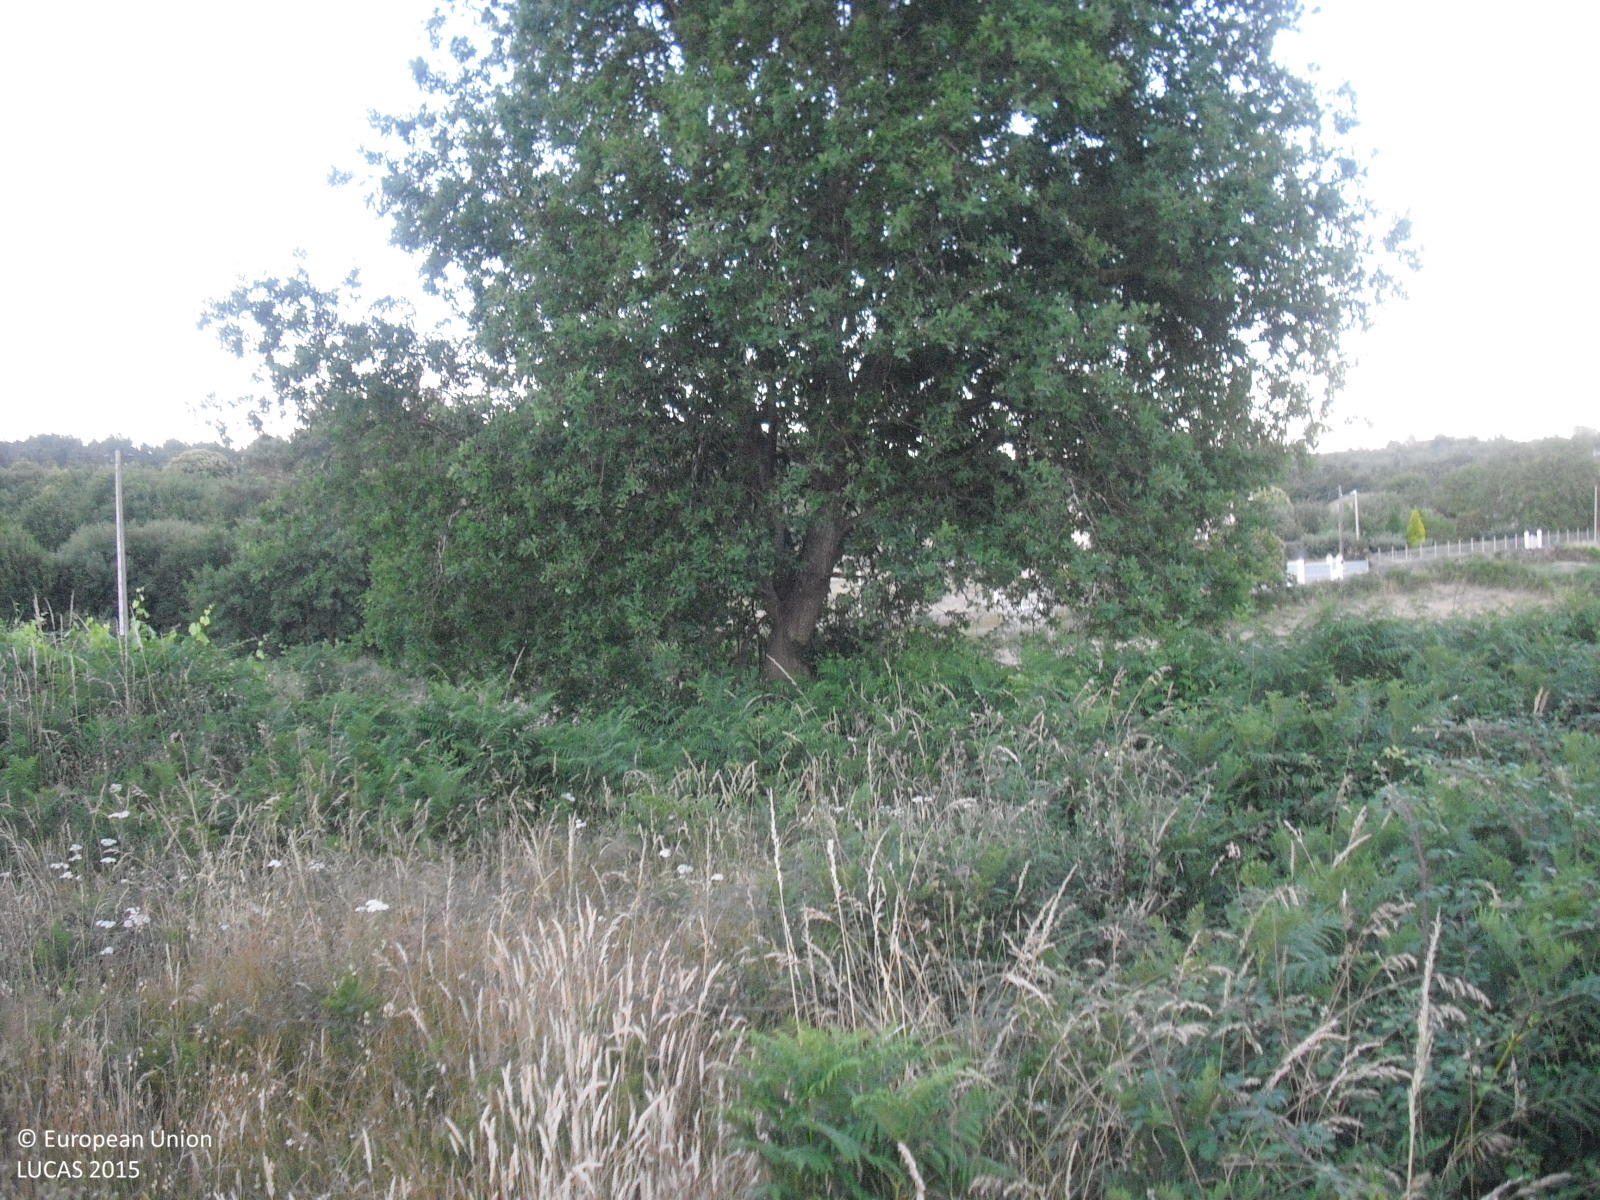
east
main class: Shrubland
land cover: Shrubland without tree cover
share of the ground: 50 - 75 %
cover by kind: shrubs 70 %, herbaceous plants 30 %
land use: Abandoned areas
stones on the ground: 25 - 50 %
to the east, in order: Shrubland without tree cover; Single bushes/trees; Dry stone walls; Shruby margins; Grassland without tree/shrub cover; Electric lines; Shruby margins; Dry stone walls; Shruby margins; Paved roads, cycling and walking lanes; Shruby margins; Fences; Grassland without tree/shrub cover; Grassland with sparse tree/shrub cover; Fences; Spontaneously vegetated surfaces; Fences; Grassland without tree/shrub cover; Shruby margins; Dry stone walls; Shruby margins; Grassland without tree/shrub cover; Dry stone walls; Other fruit trees and berries
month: June
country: ES
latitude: 42.4697
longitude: -7.8731
